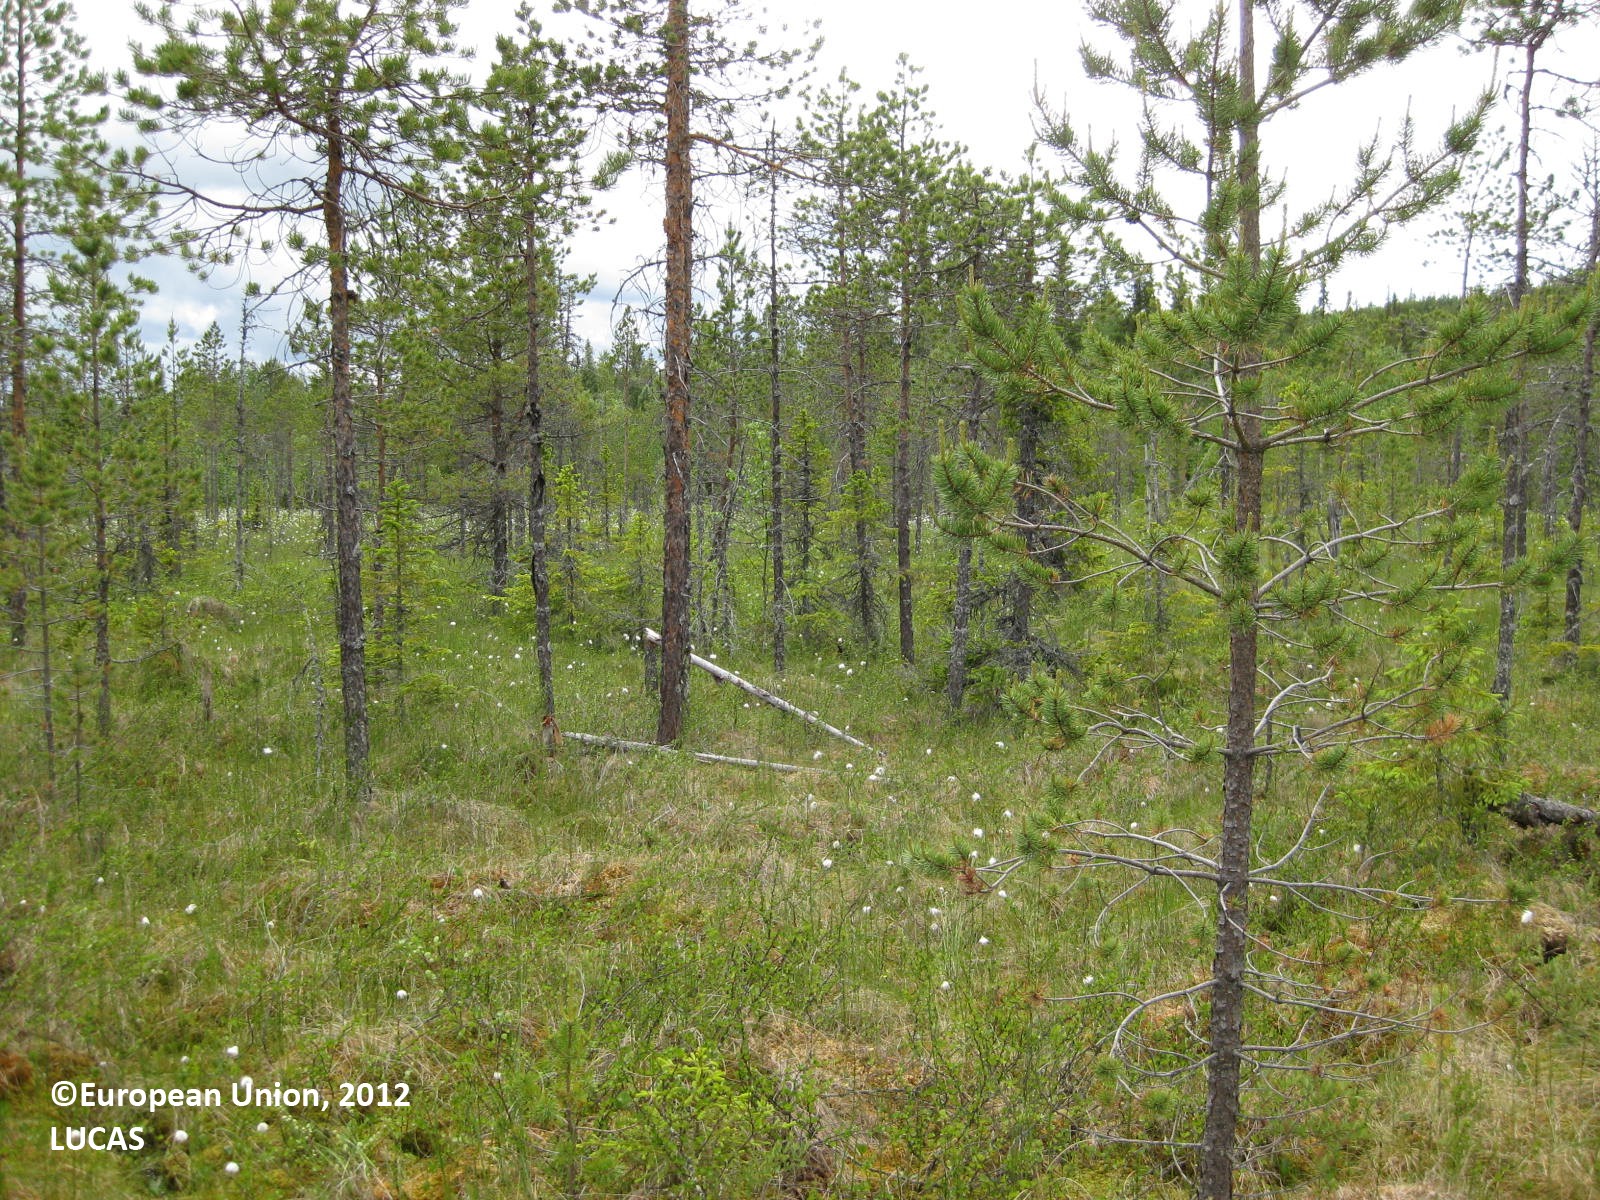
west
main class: Woodland
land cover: Pine dominated coniferous woodland
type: boreal forest
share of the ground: 50 - 75 %
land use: Semi-natural and natural areas not in use
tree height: > 5 m
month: June
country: FI
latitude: 65.3224
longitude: 28.2512
